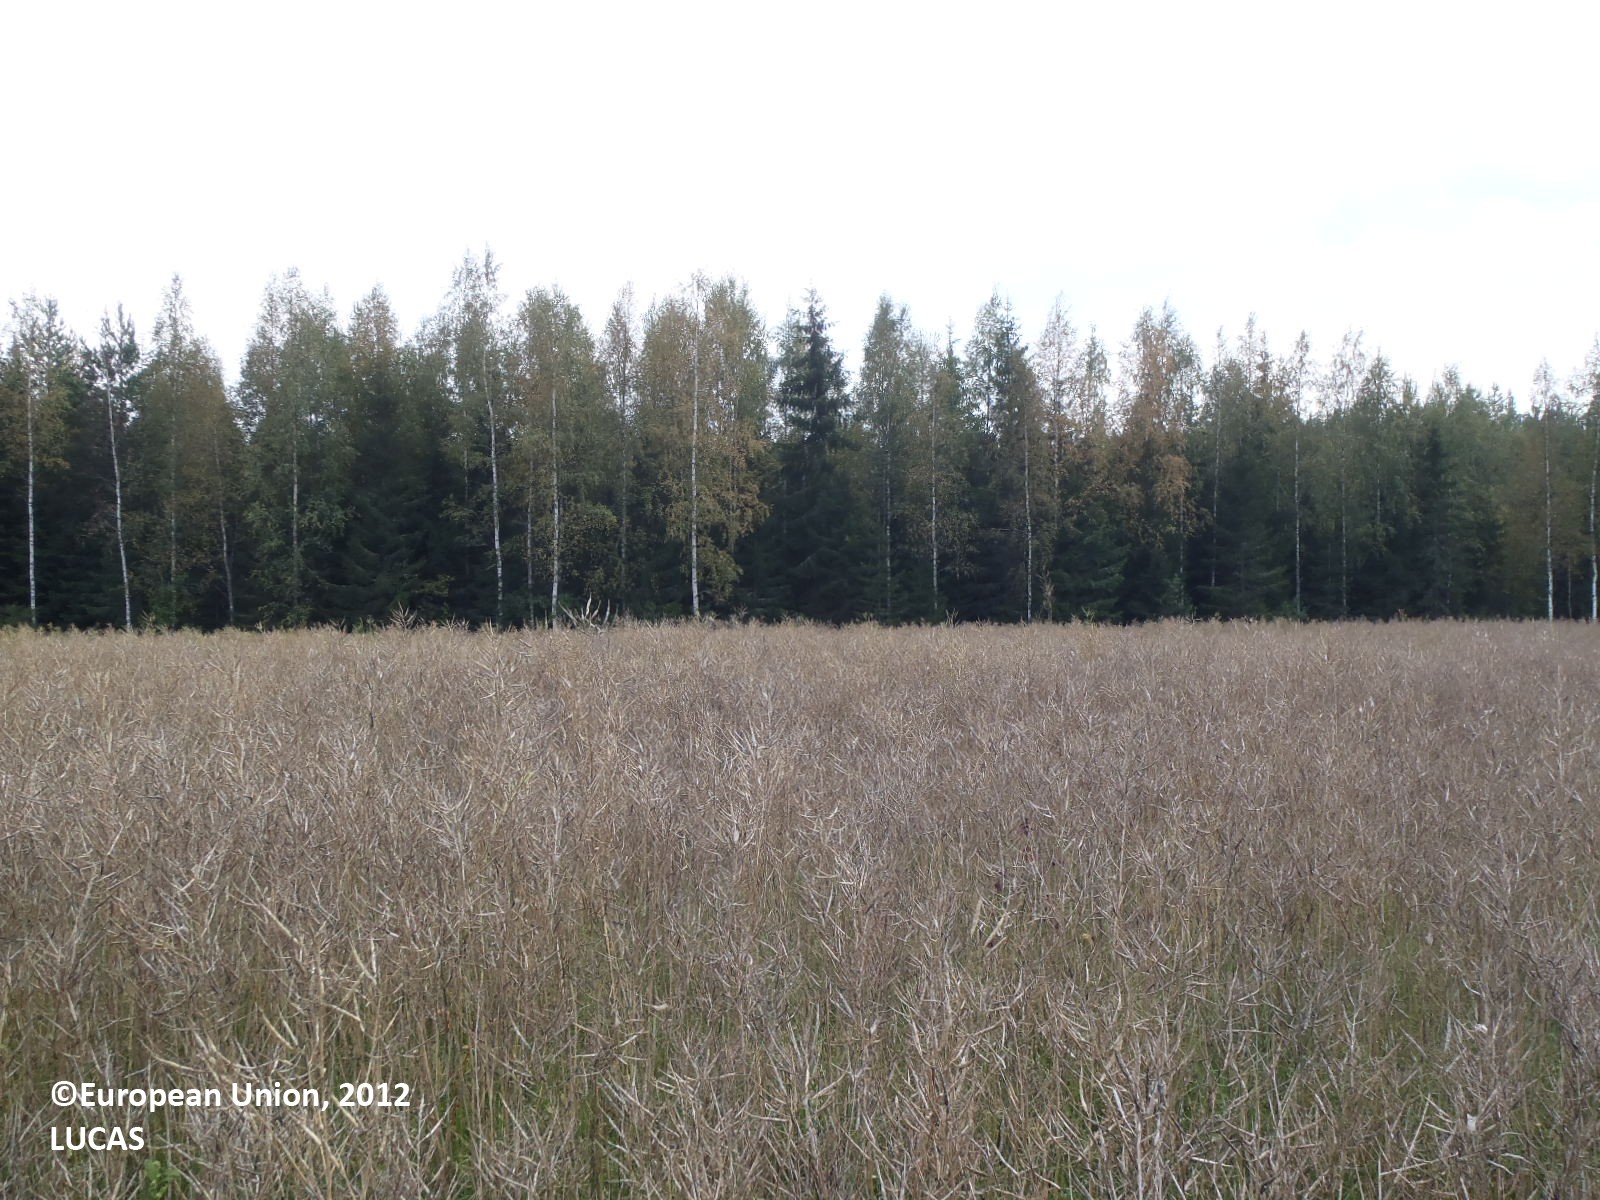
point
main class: Cropland
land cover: Rape and turnip rape
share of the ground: > 75 %
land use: Agriculture (excluding fallow land and kitchen gardens)
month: August
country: FI
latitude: 60.9318
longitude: 22.5598
